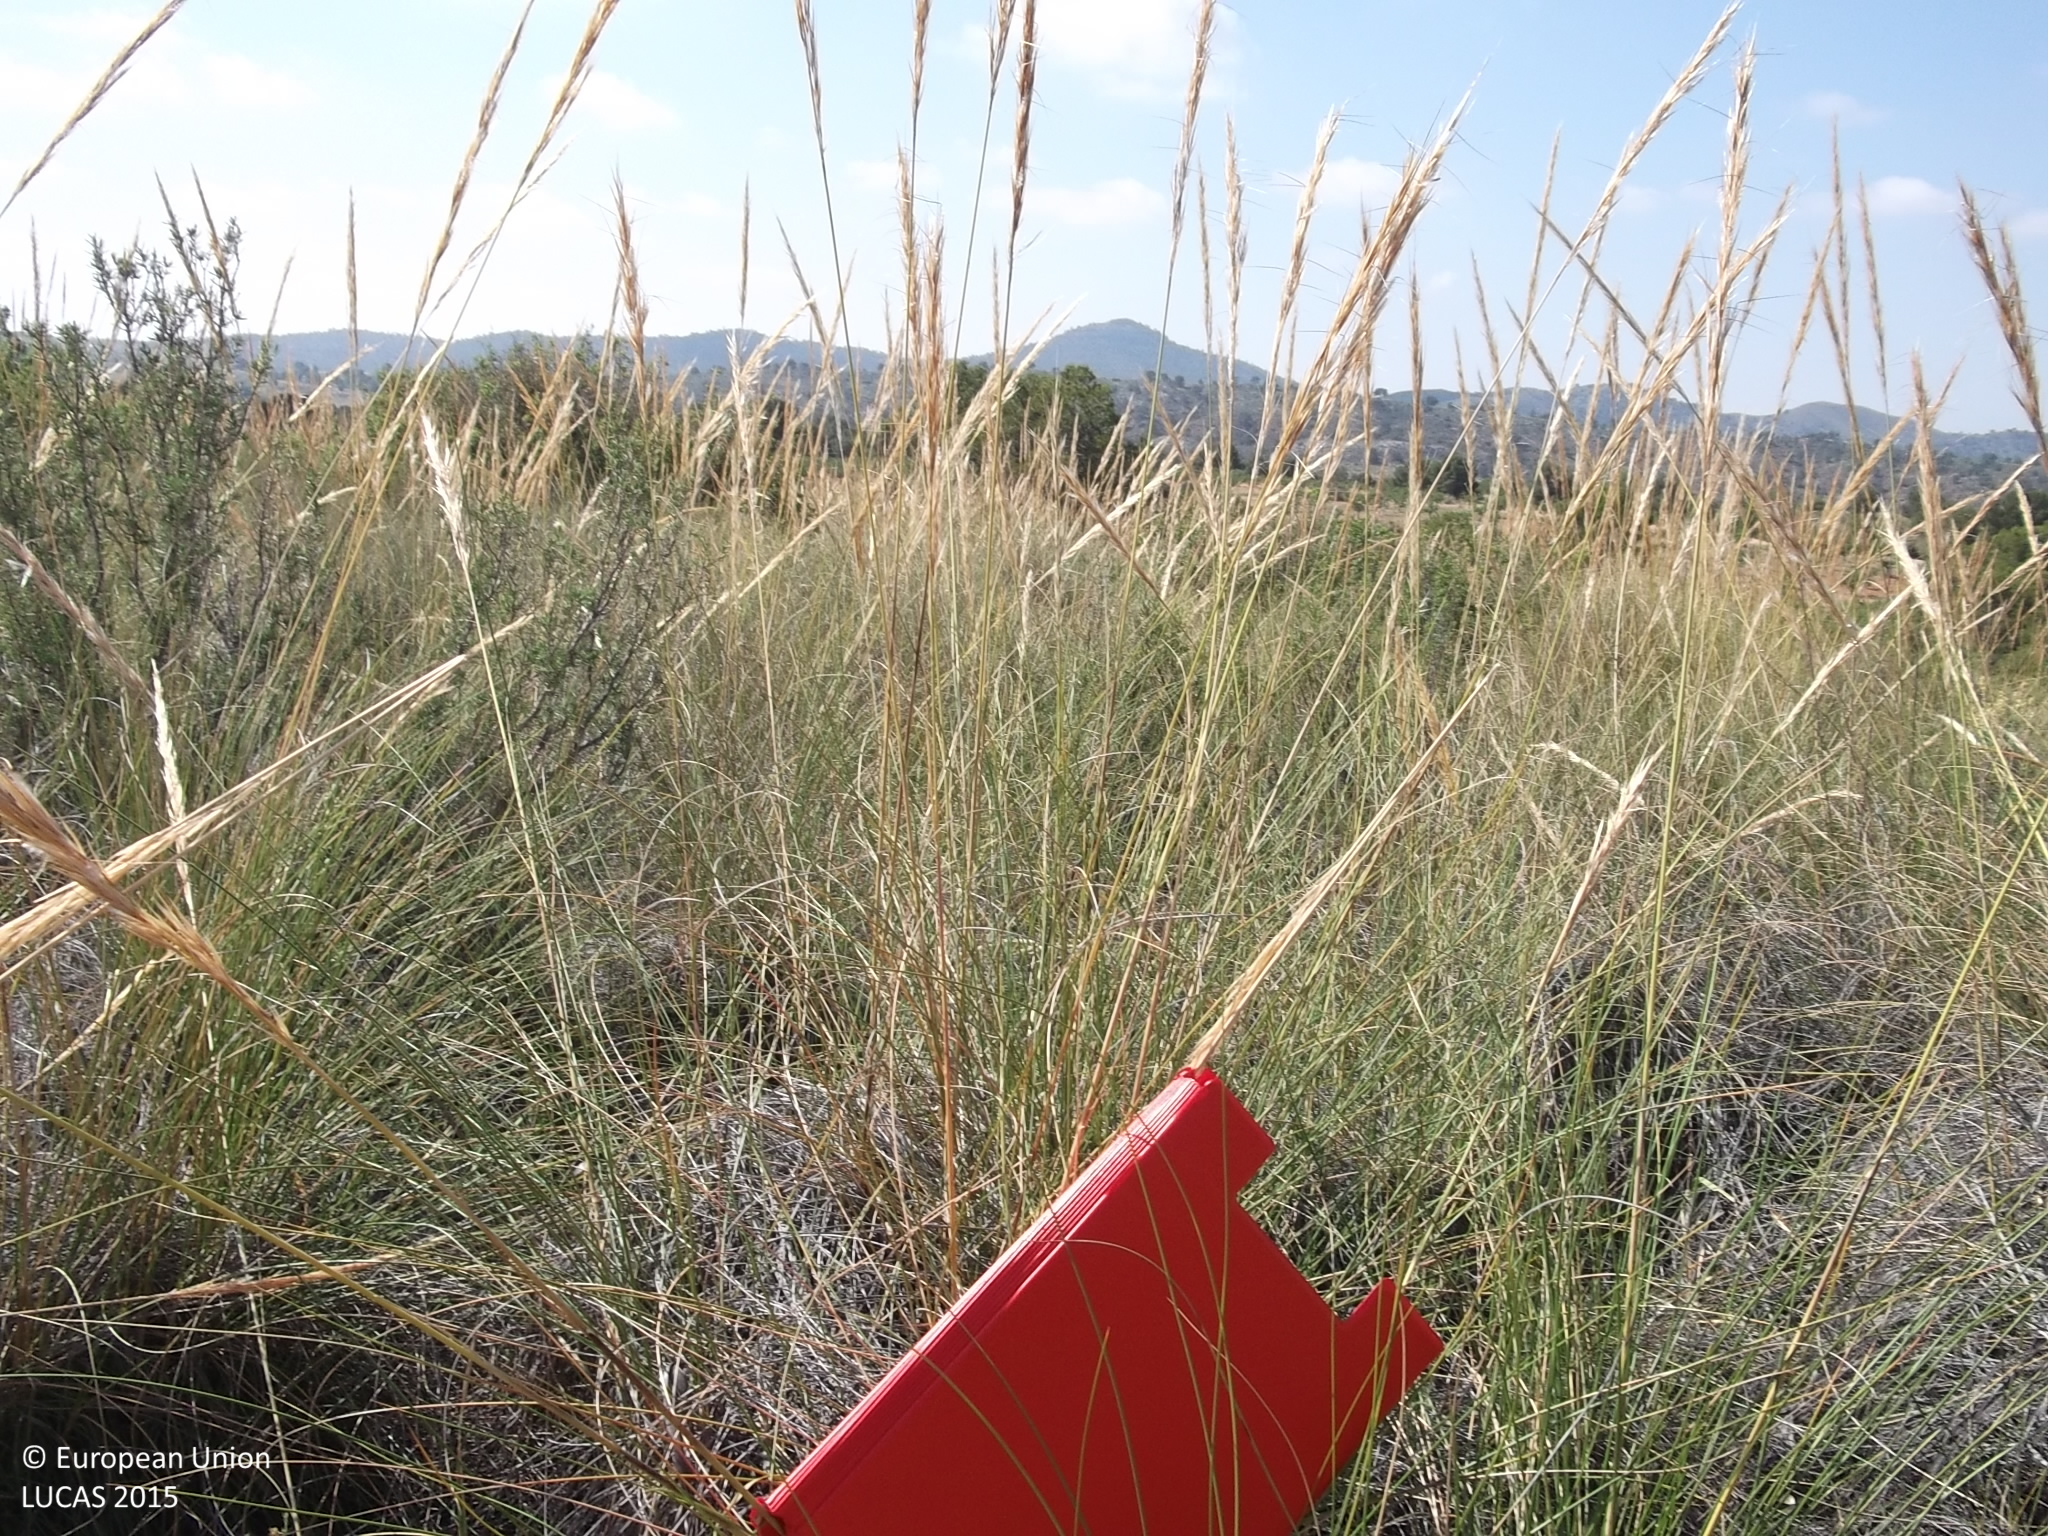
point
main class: Shrubland
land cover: Shrubland without tree cover
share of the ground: 50 - 75 %
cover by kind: shrubs 50 %, herbaceous plants 30 %, consolidated bare surface 20 %
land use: Semi-natural and natural areas not in use
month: May
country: ES
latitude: 38.4756
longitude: -1.4885
